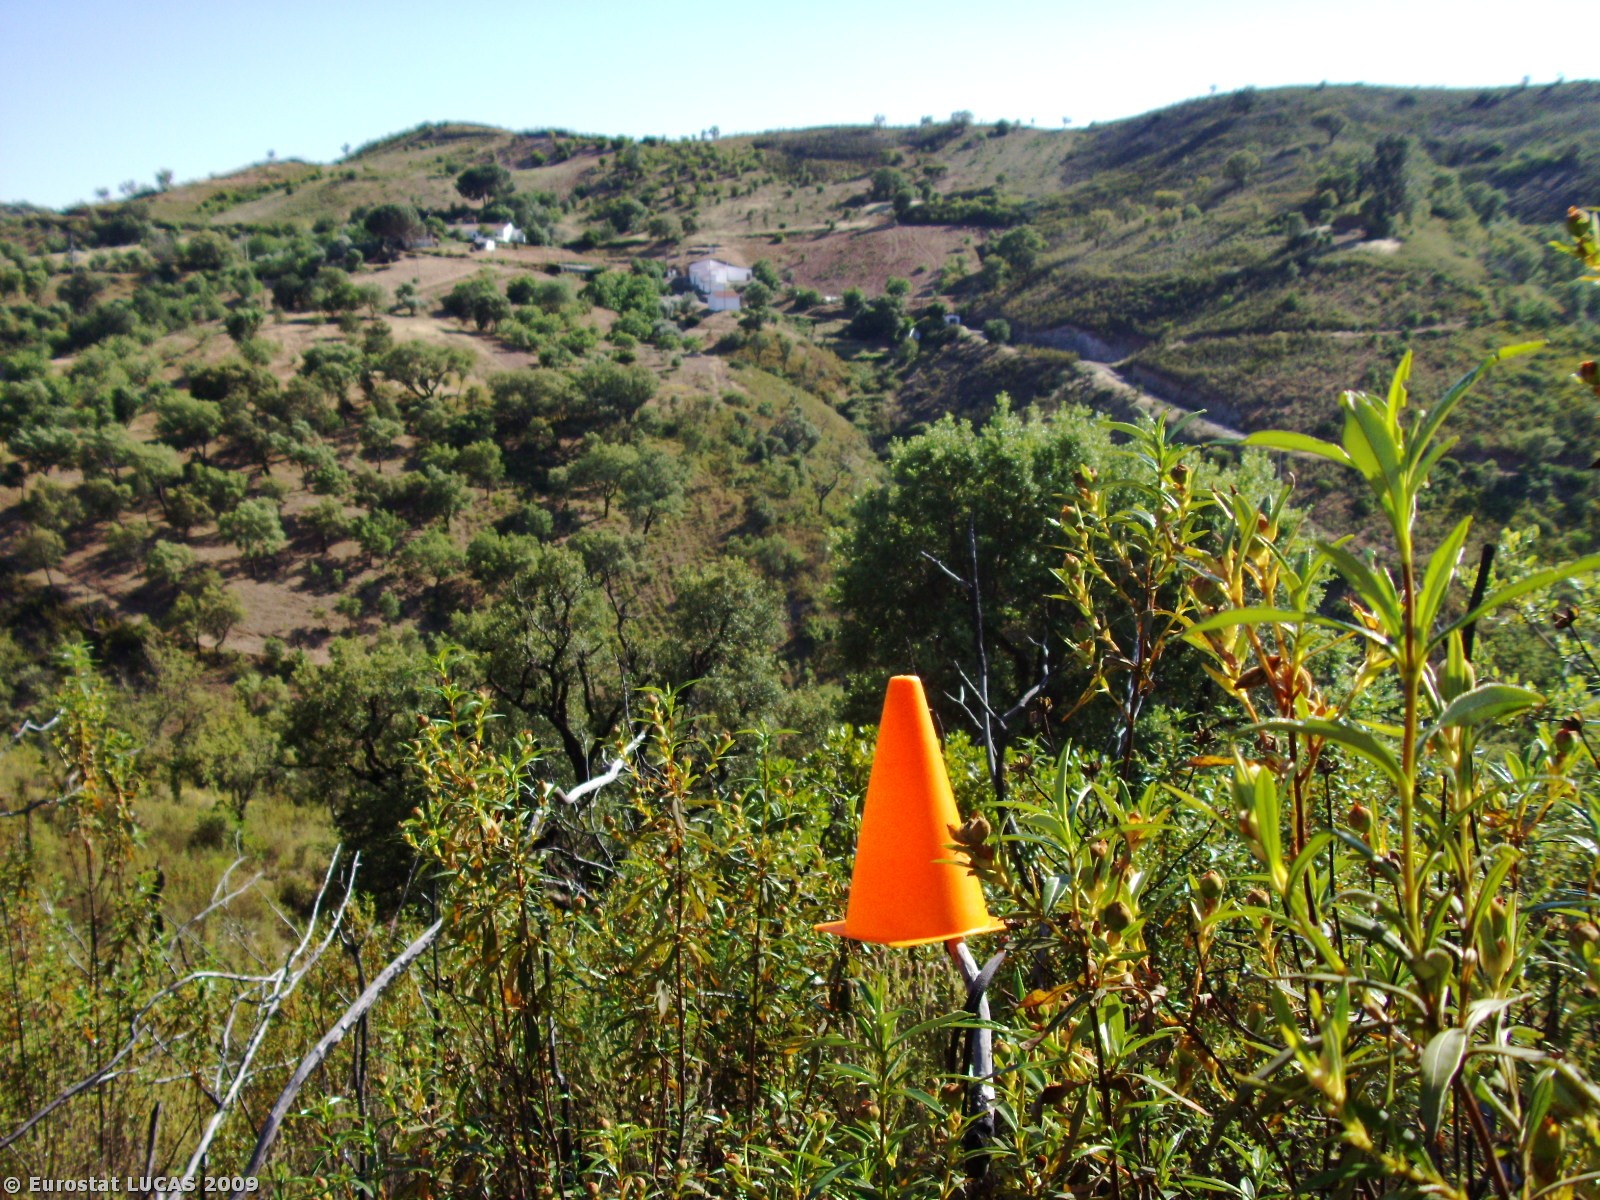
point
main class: Shrubland
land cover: Shrubland with sparse tree cover
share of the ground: > 75 %
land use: Nature reserves
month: May
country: PT
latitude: 37.3093
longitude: -8.1977
